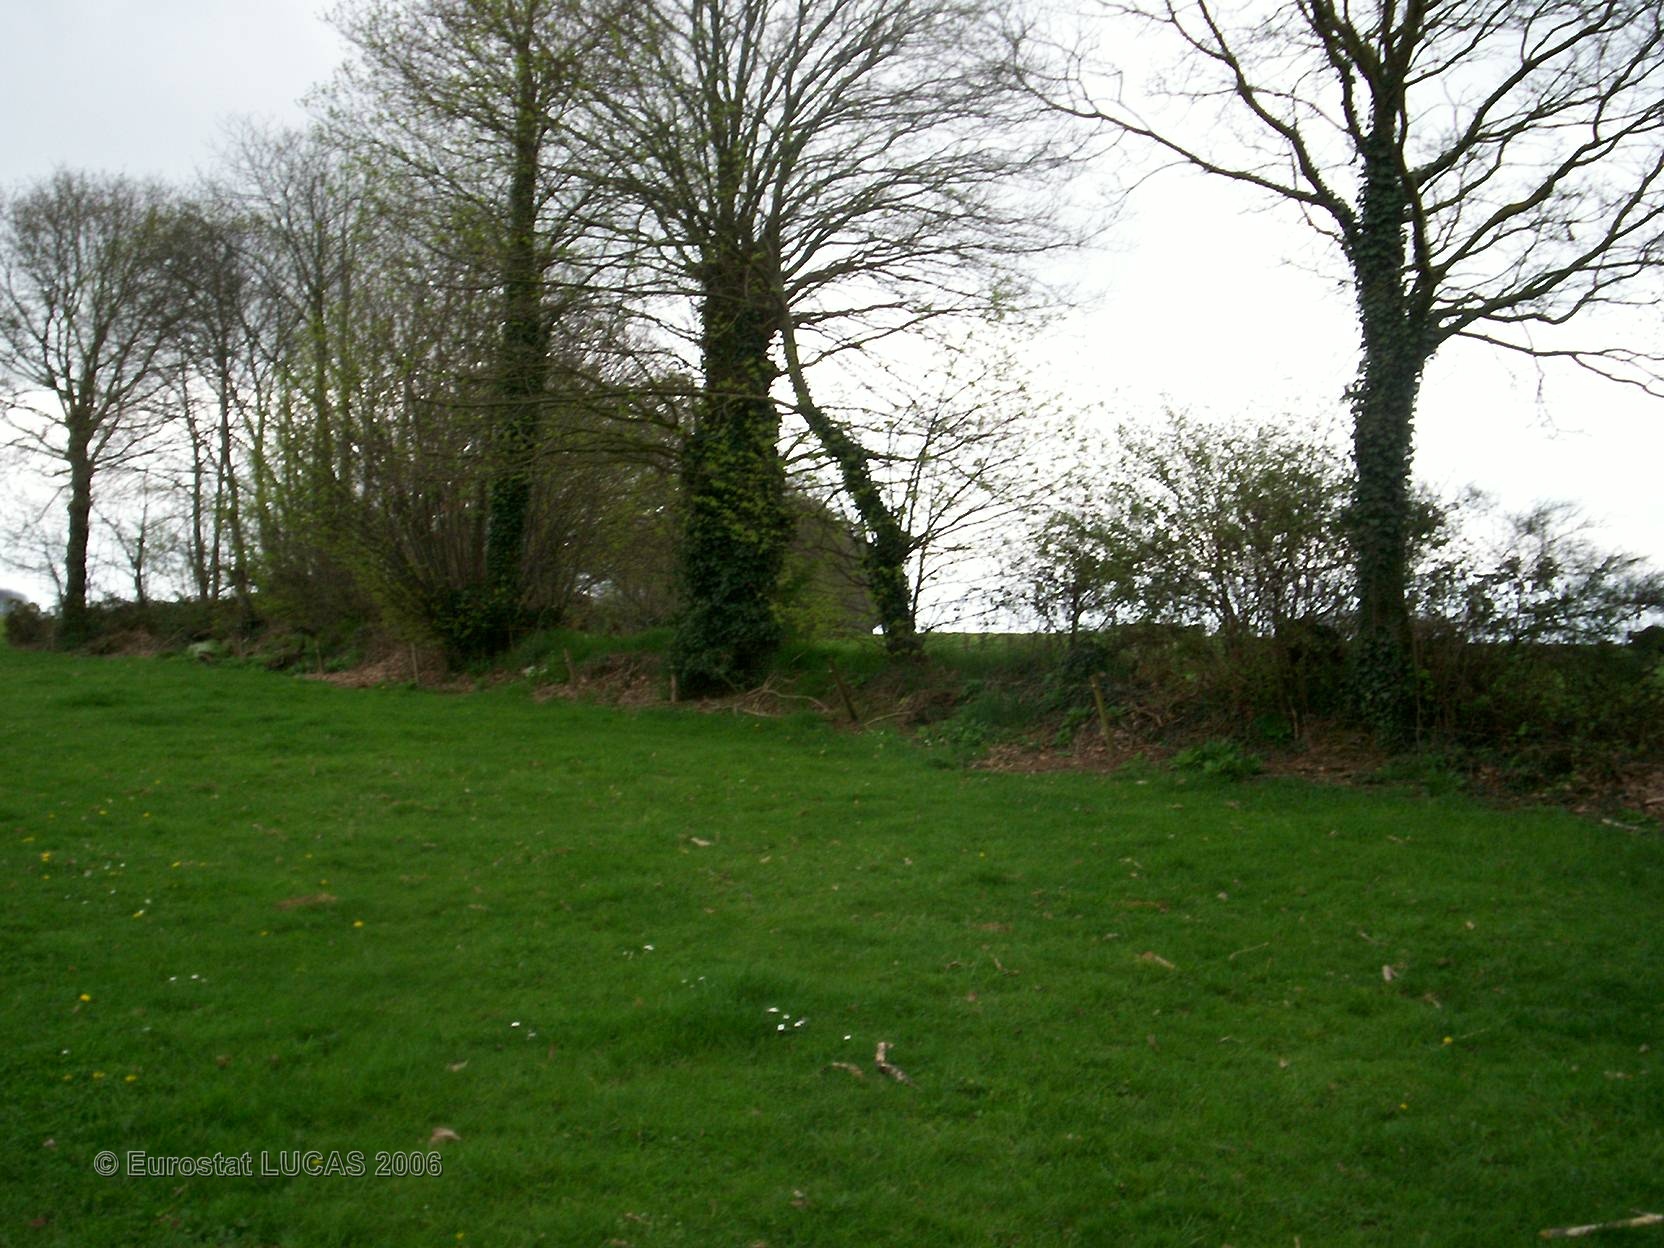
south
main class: Grassland
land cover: Grassland without tree/shrub cover
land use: Agriculture (excluding fallow land and kitchen gardens)
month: April
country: FR
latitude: 48.1175
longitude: -2.4309
